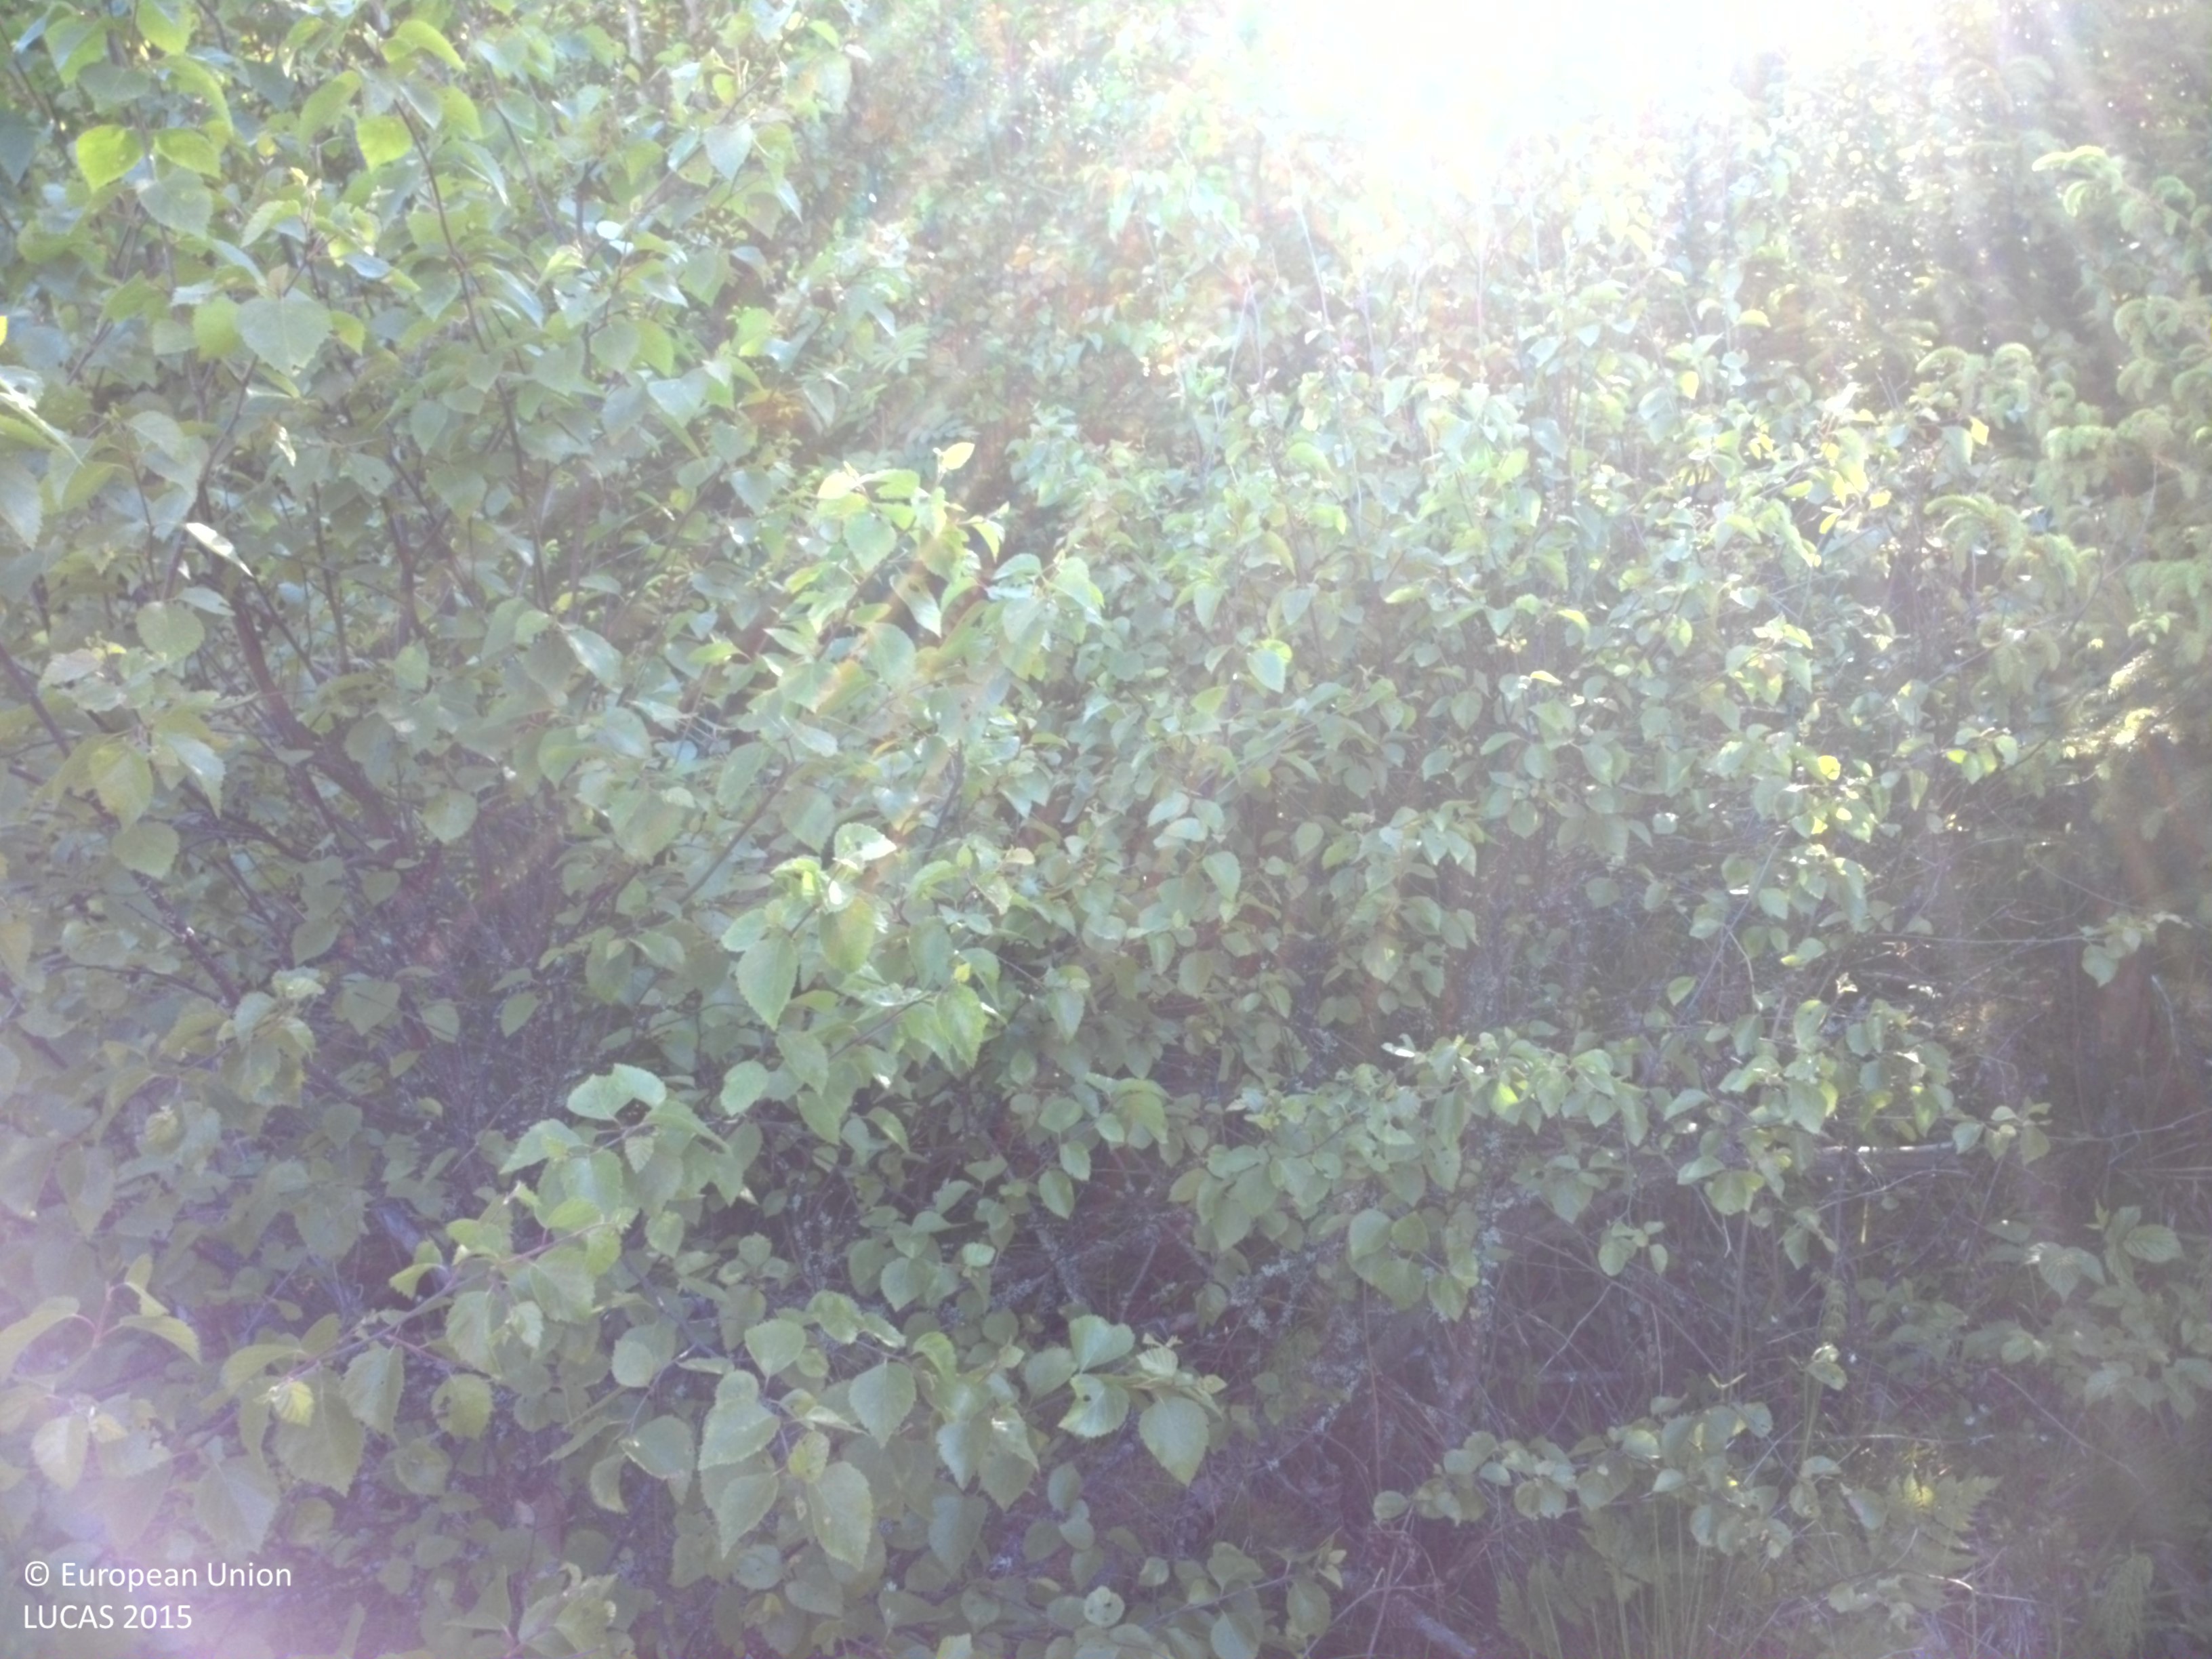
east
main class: Woodland
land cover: Spruce dominated mixed woodland
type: boreal forest
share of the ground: 25 - 50 %
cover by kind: coniferous forest trees 30 %, shrubs 25 %, herbaceous plants 25 %, broadleaved forest trees 20 %
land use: Forestry
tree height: < 5 m
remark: Clear cut
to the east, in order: Spruce dominated mixed woodland; Spruce dominated coniferous woodland; Rivers and streams; Spruce dominated coniferous woodland
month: June
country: SE
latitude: 59.5523
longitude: 12.1350
